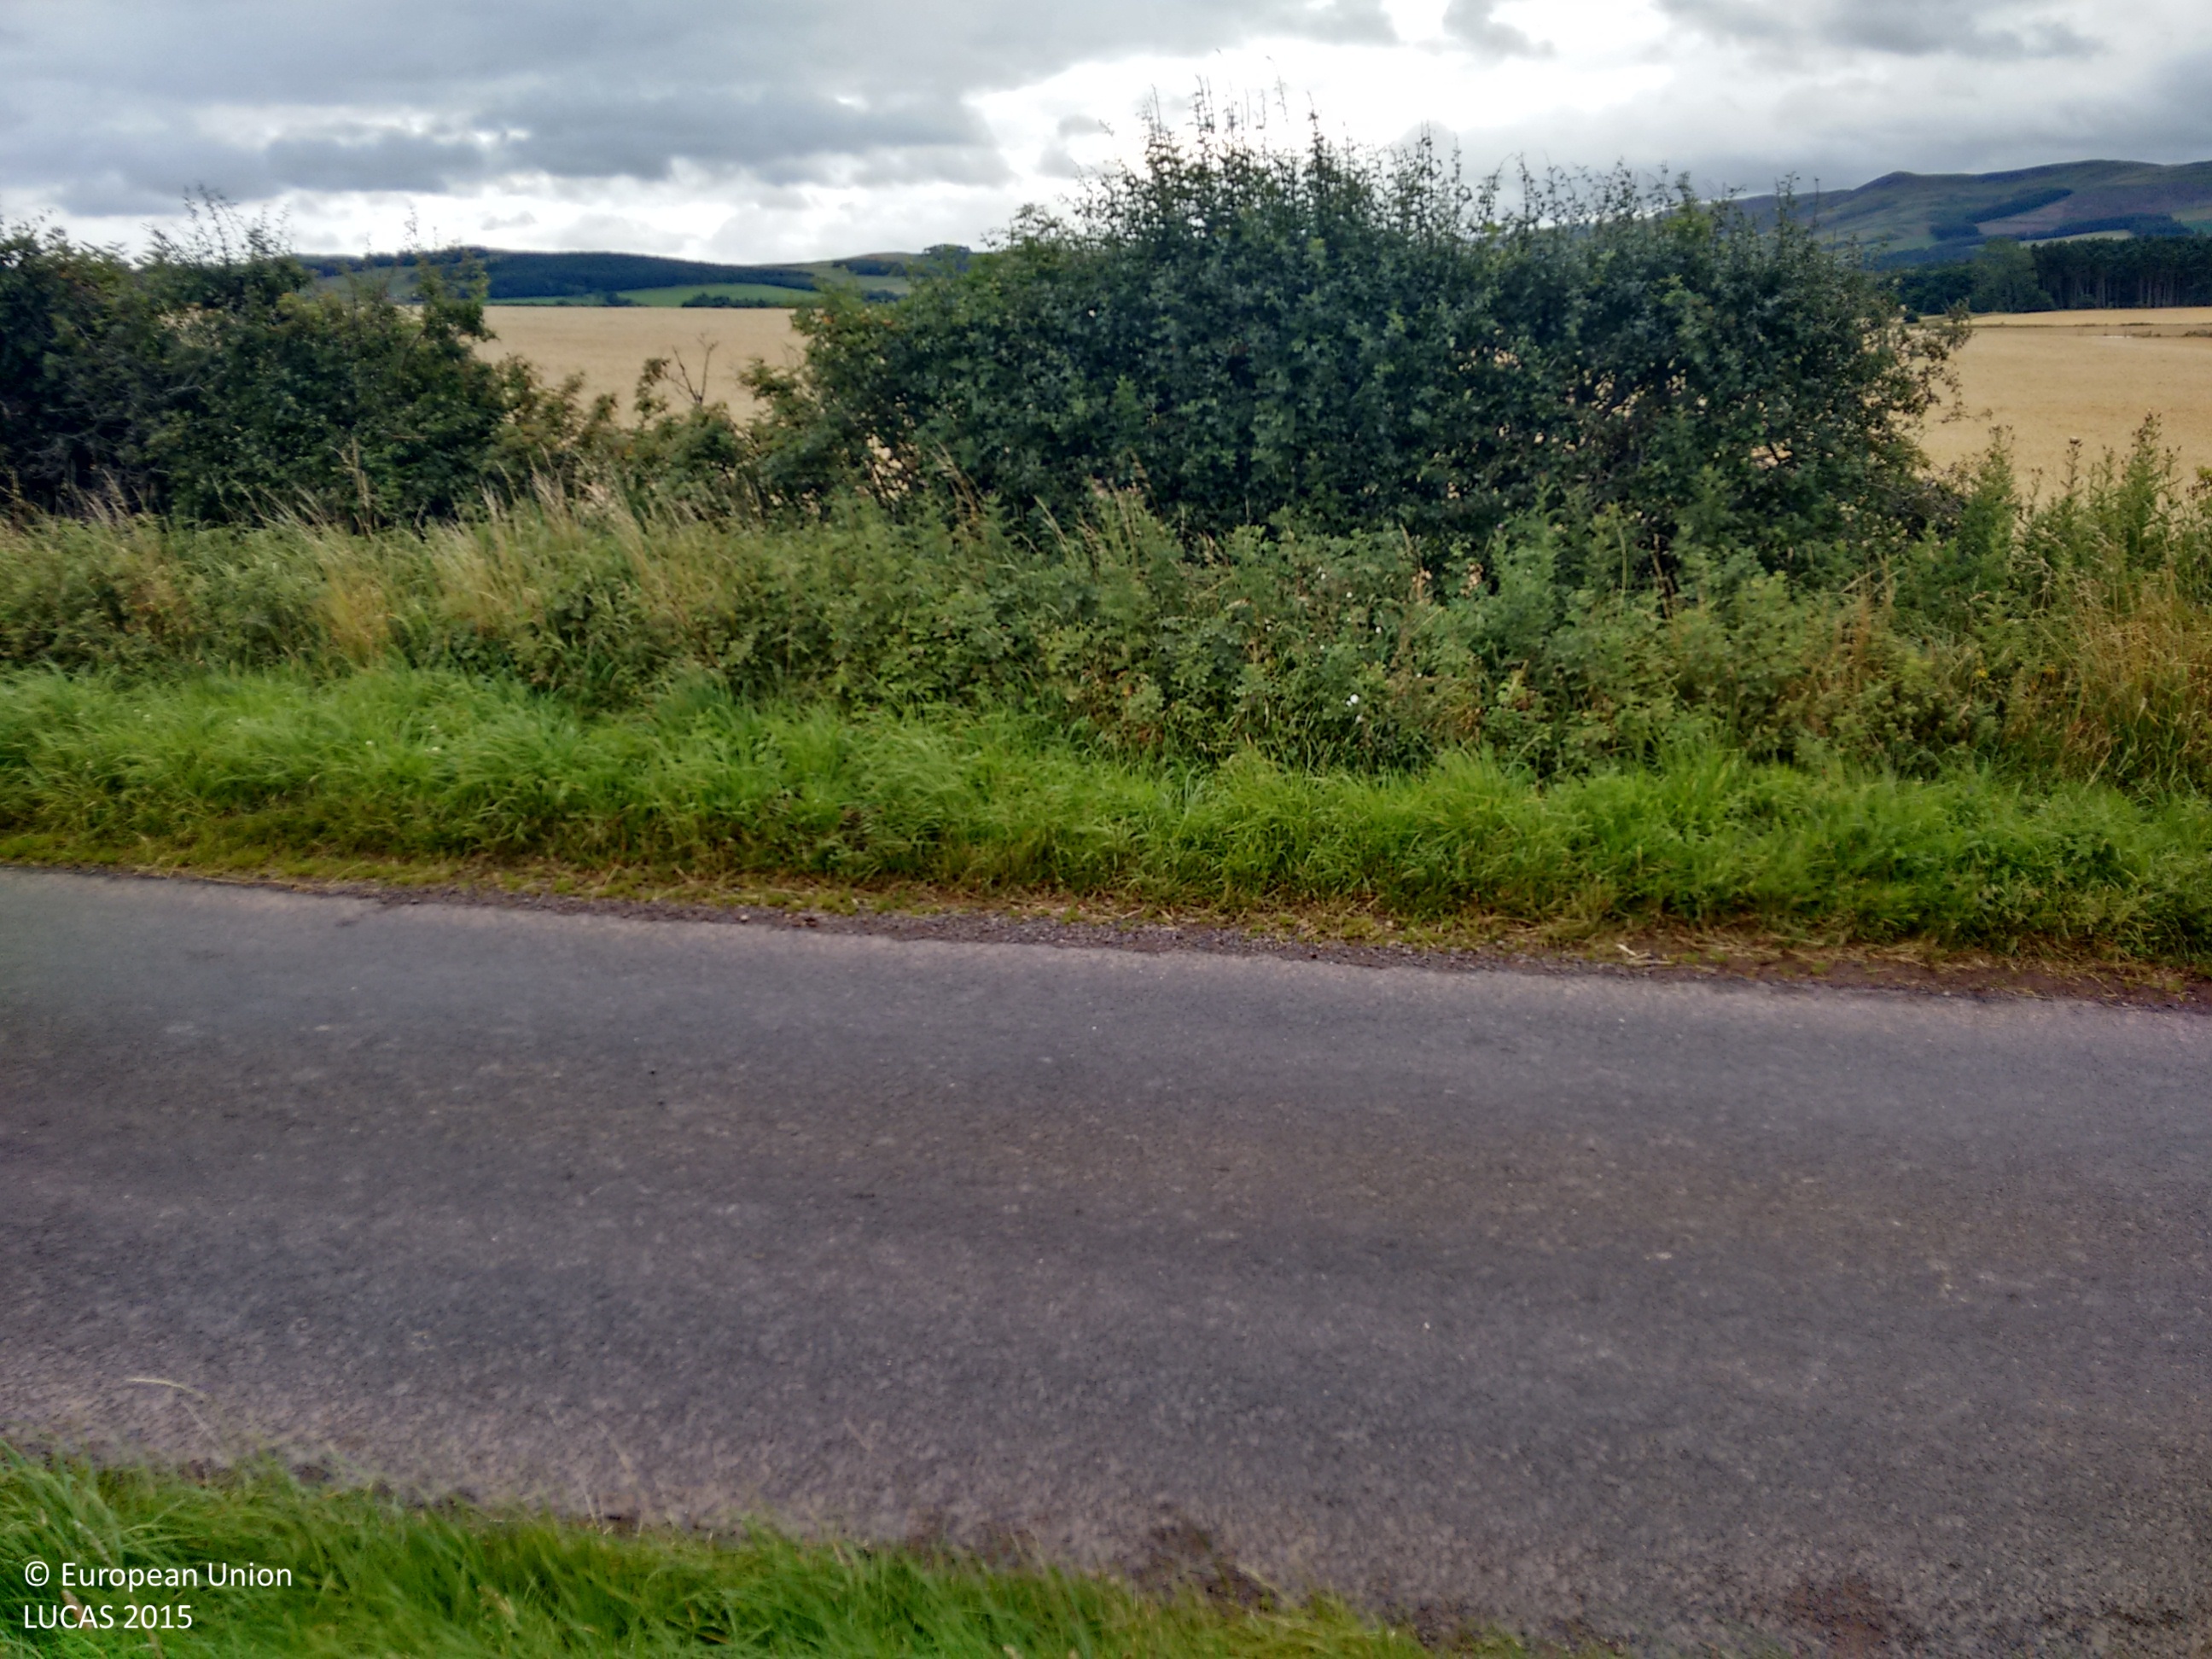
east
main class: Cropland
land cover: Other fresh vegetables
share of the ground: > 75 %
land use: Agriculture (excluding fallow land and kitchen gardens)
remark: Tilled/Sowed
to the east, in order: Other fresh vegetables; Grass margins; Managed hedges; Fences; Grass margins; Paved roads, cycling and walking lanes; Grass margins; Electric lines; Managed hedges
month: August
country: GB
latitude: 55.5287
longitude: -2.4004
